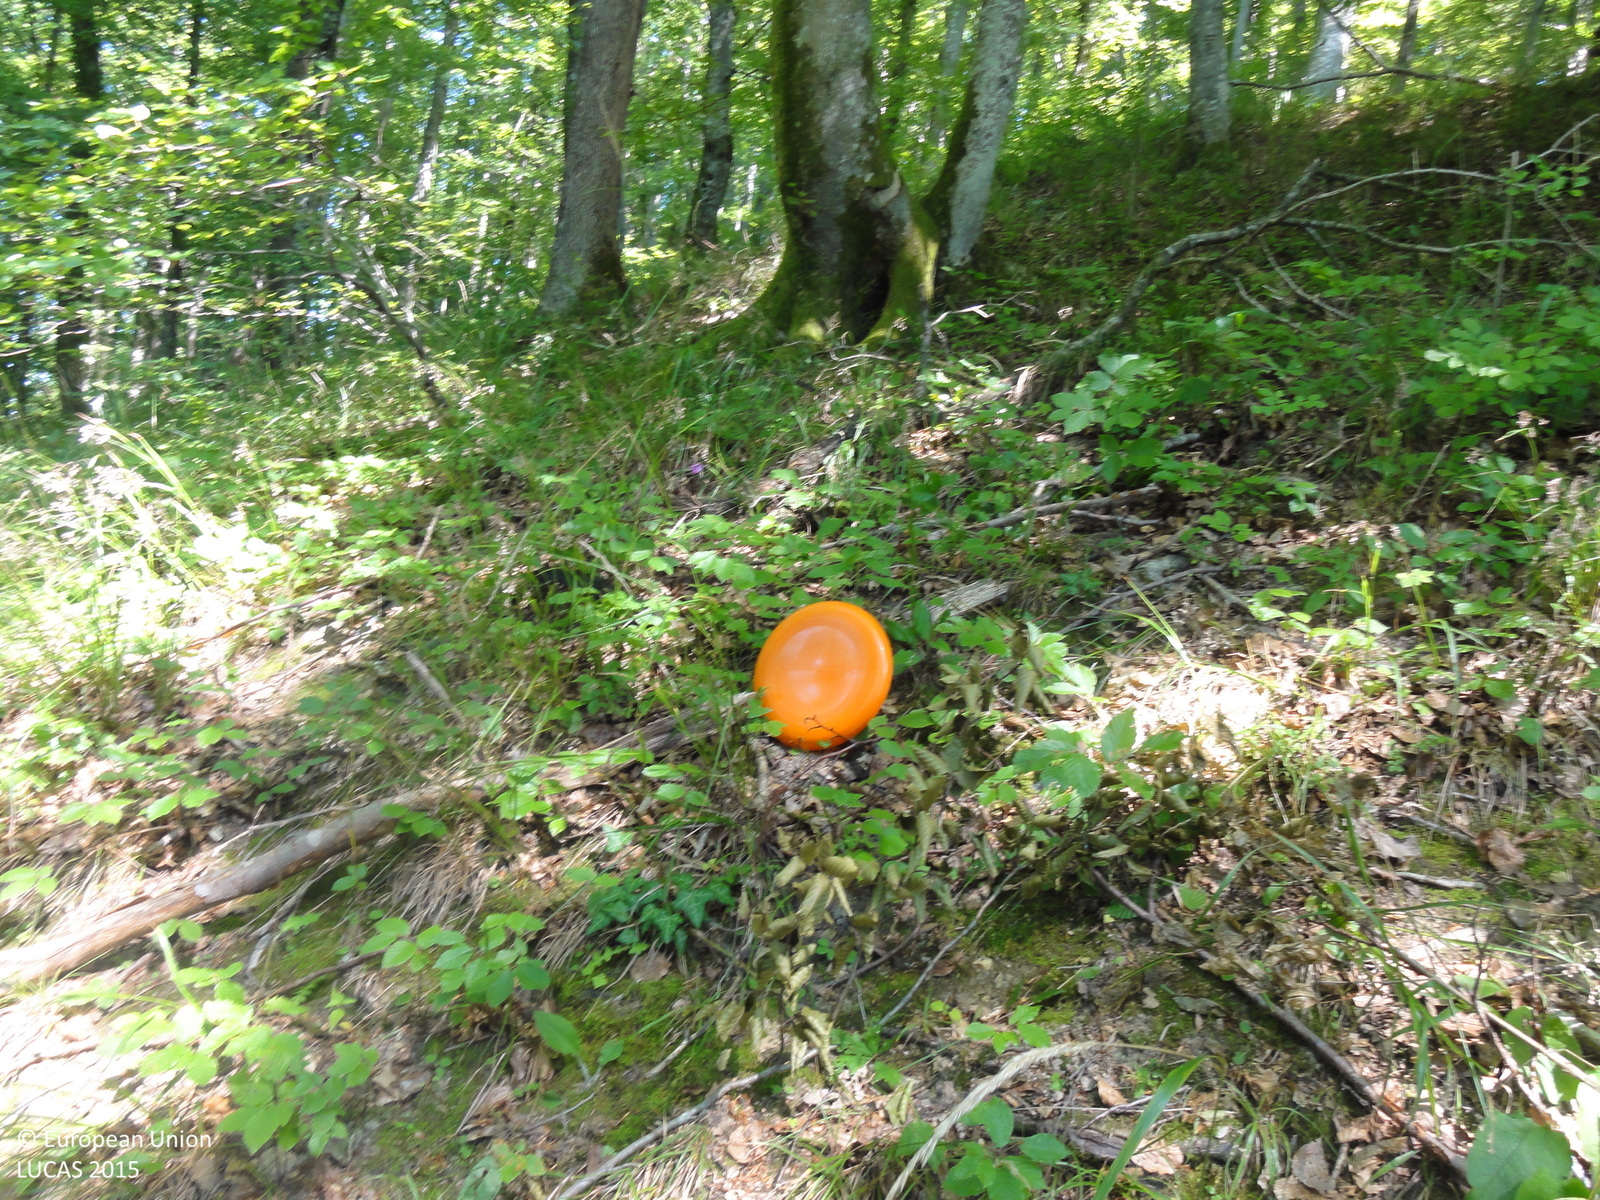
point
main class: Woodland
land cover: Broadleaved woodland
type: beech forest
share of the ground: > 75 %
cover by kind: broadleaved forest trees 100 %
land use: Forestry
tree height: > 5 m
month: August
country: SI
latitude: 45.9796
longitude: 15.0437
